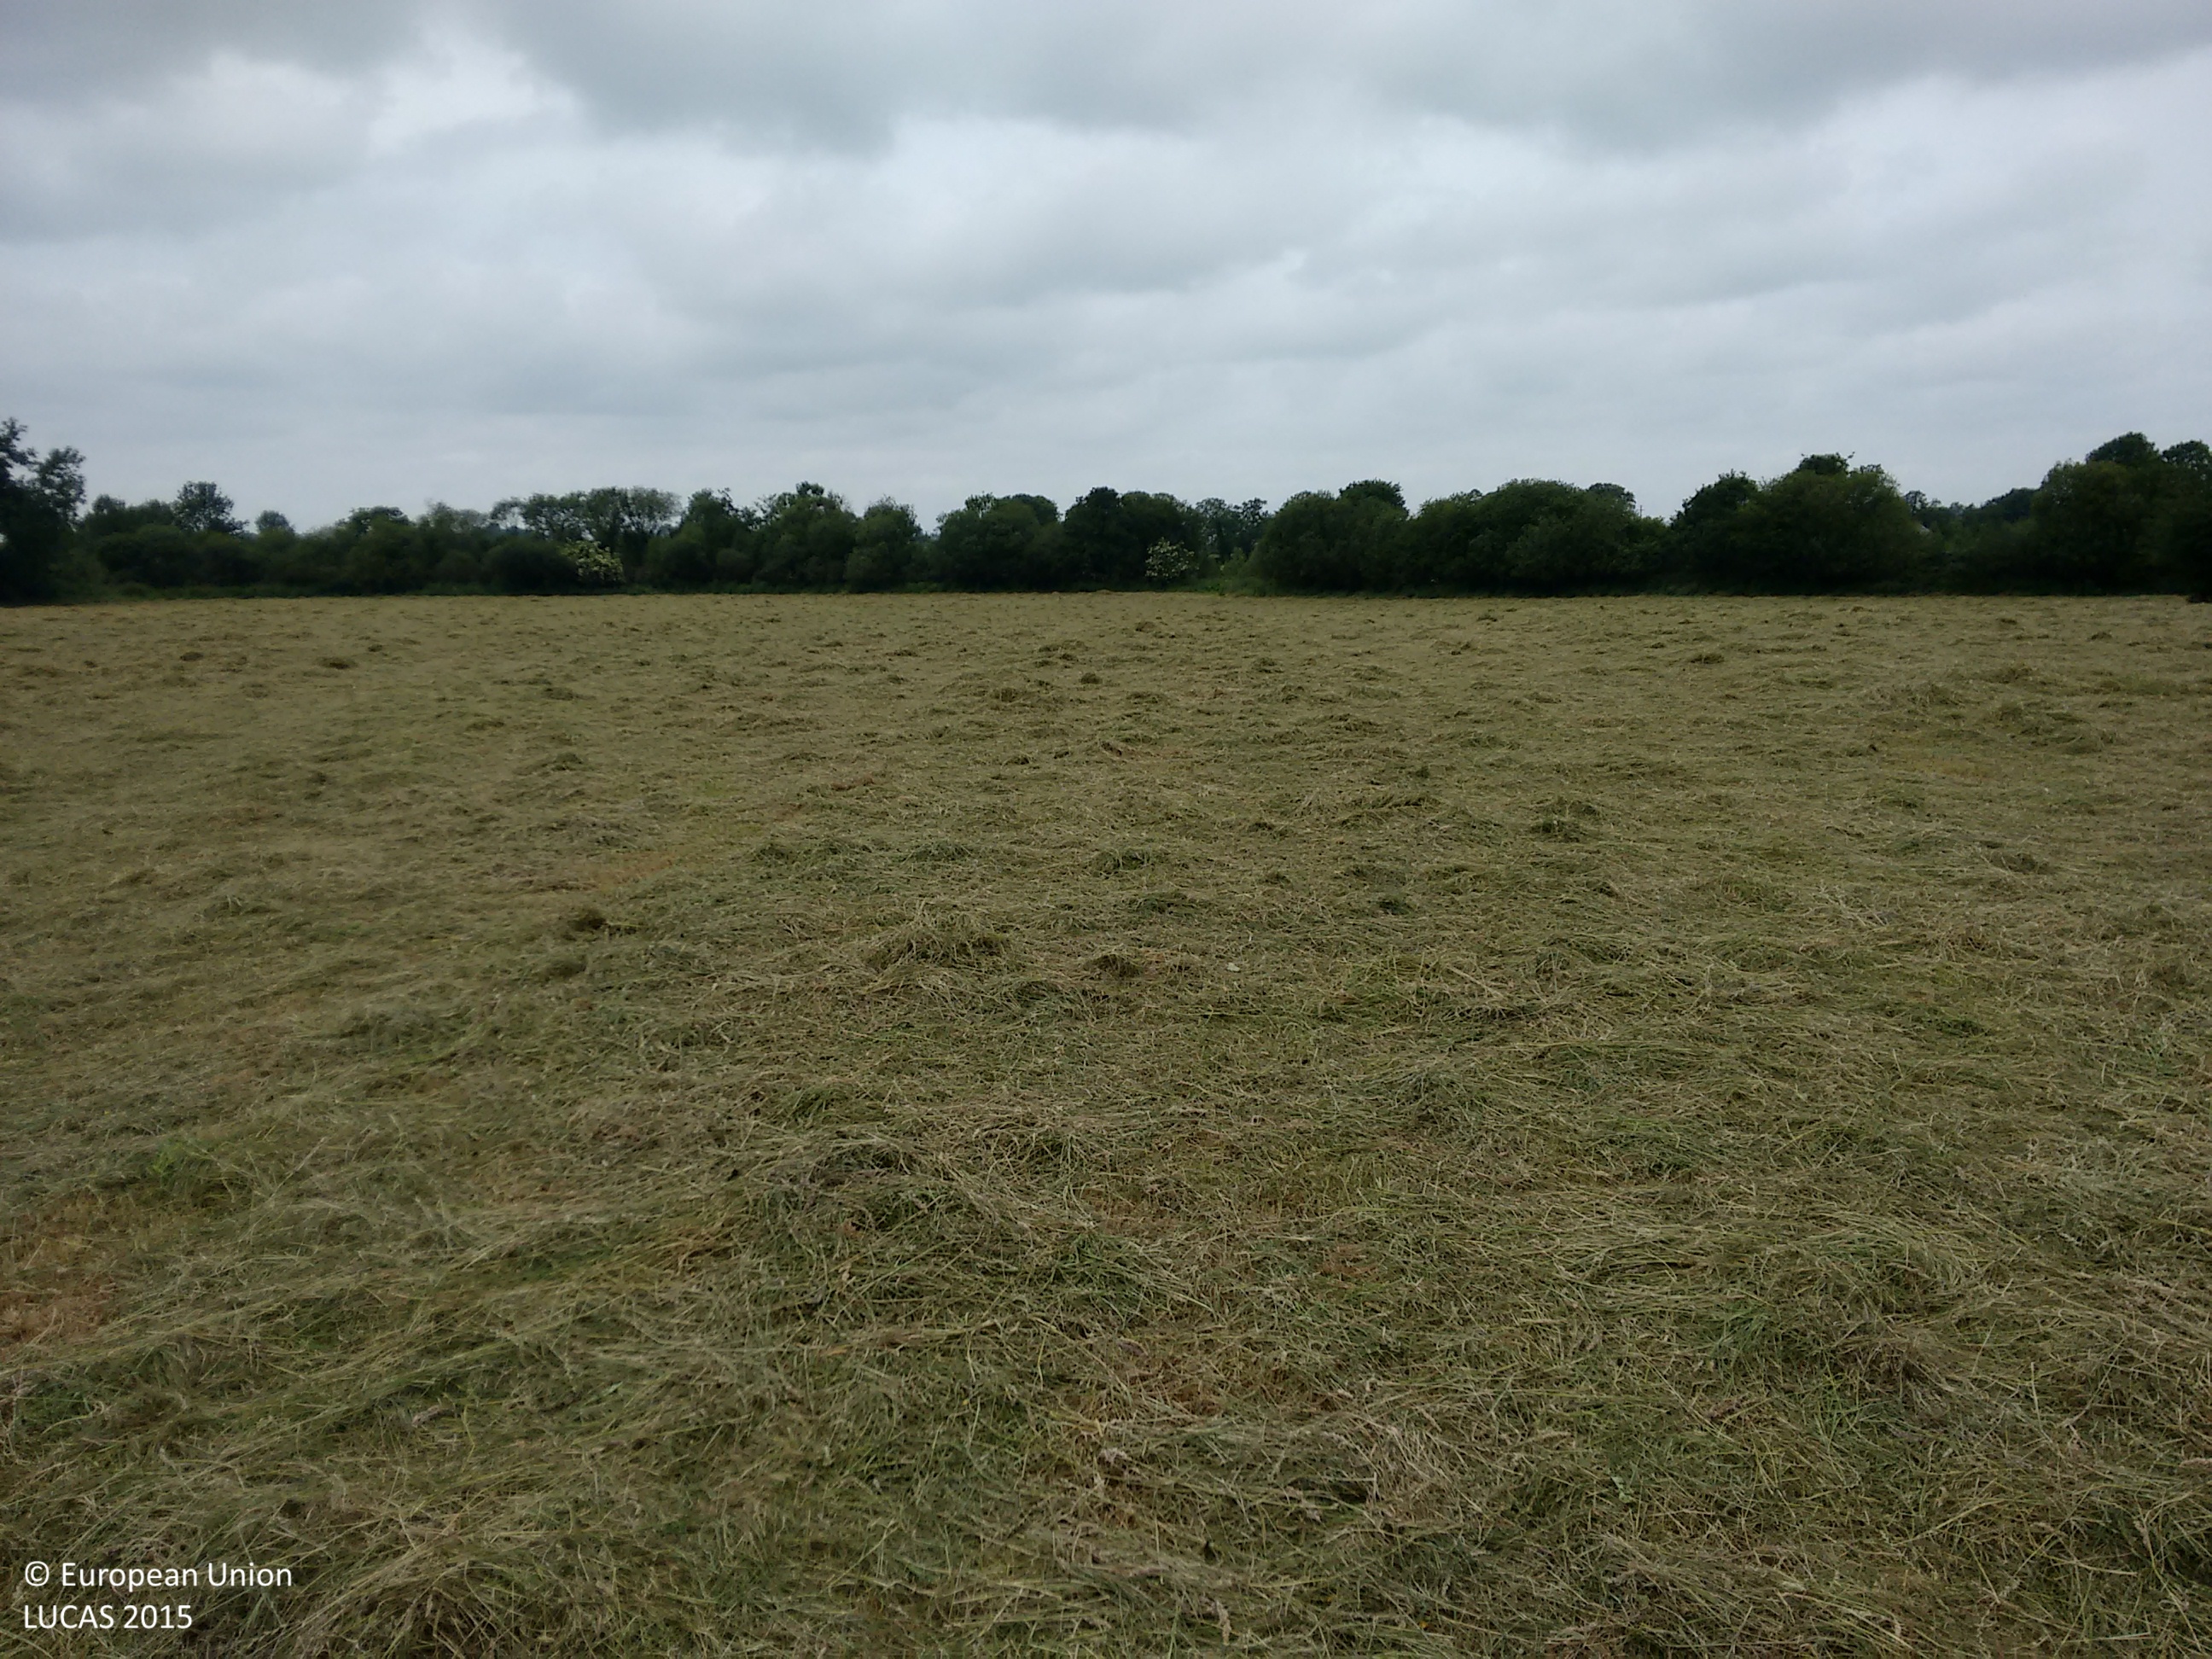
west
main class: Grassland
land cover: Grassland without tree/shrub cover
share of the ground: > 75 %
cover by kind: herbaceous plants 100 %
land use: Agriculture (excluding fallow land and kitchen gardens)
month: July
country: IE
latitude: 52.5433
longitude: -7.4537
